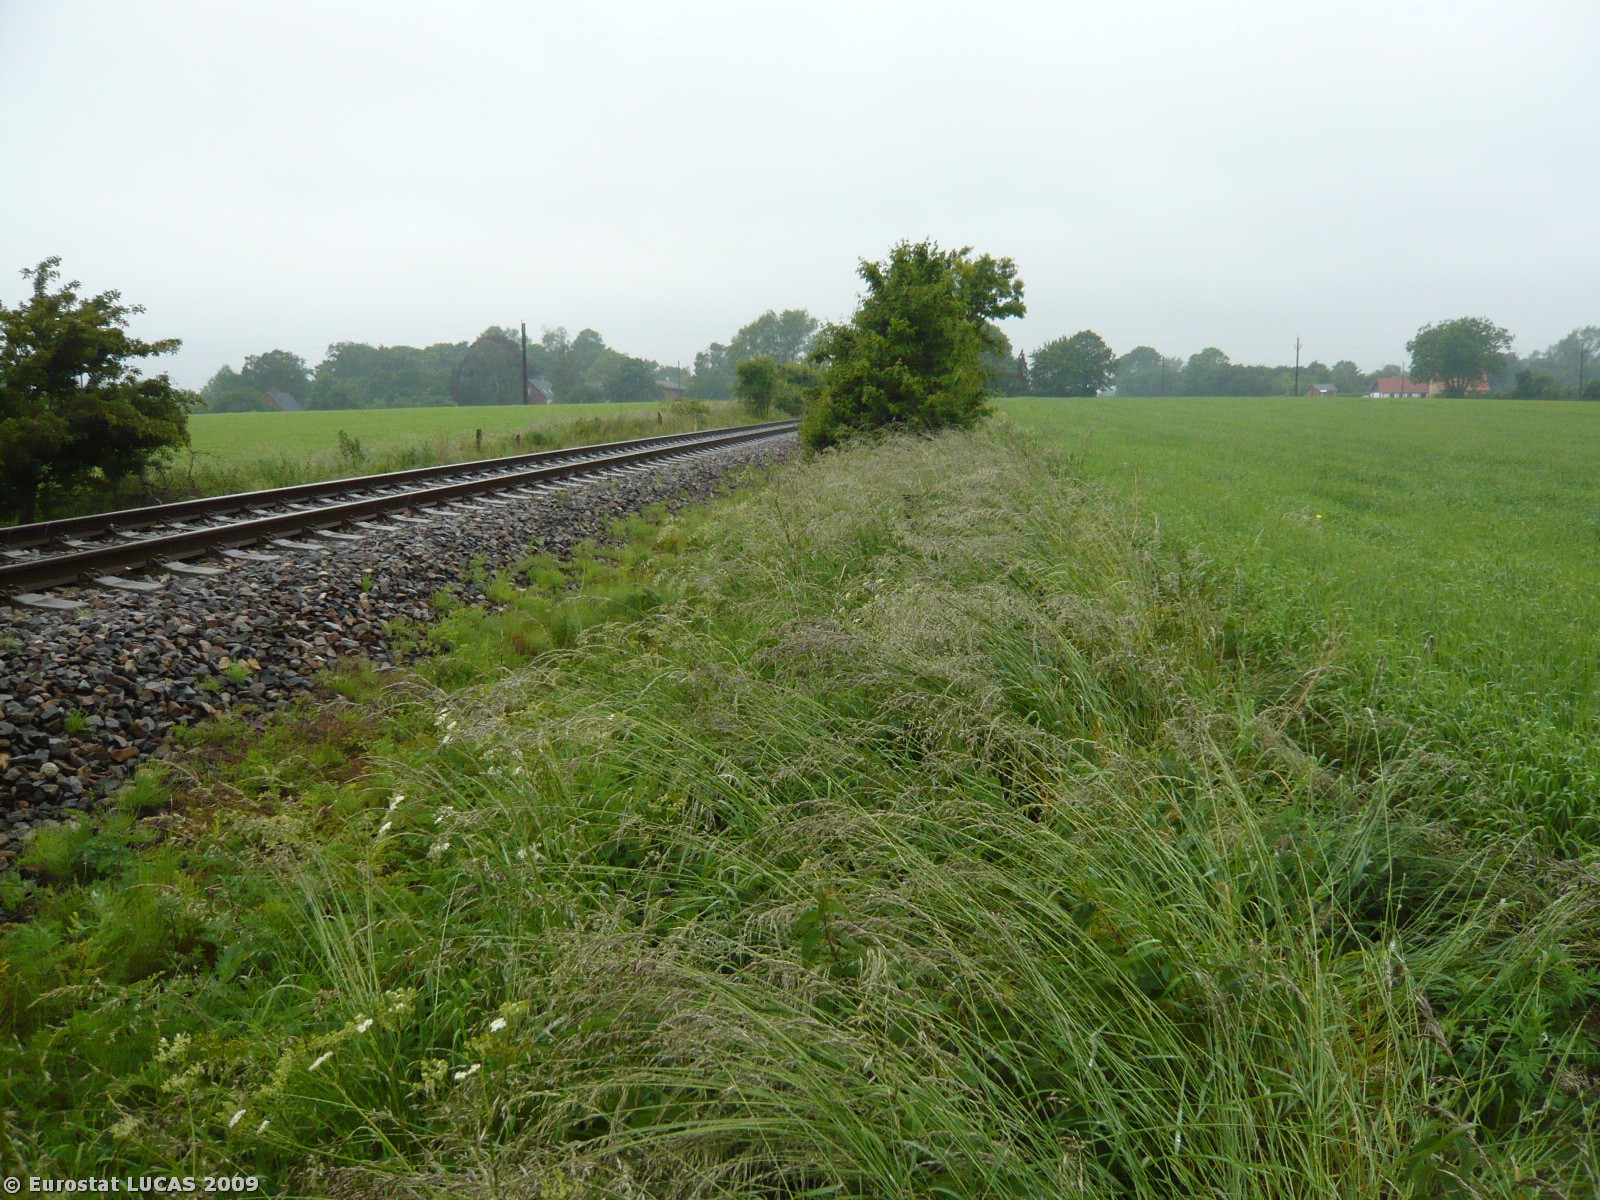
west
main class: Grassland
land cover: Grassland without tree/shrub cover
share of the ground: > 75 %
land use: Railway transport
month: June
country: DK
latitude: 54.7923
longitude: 11.6941
